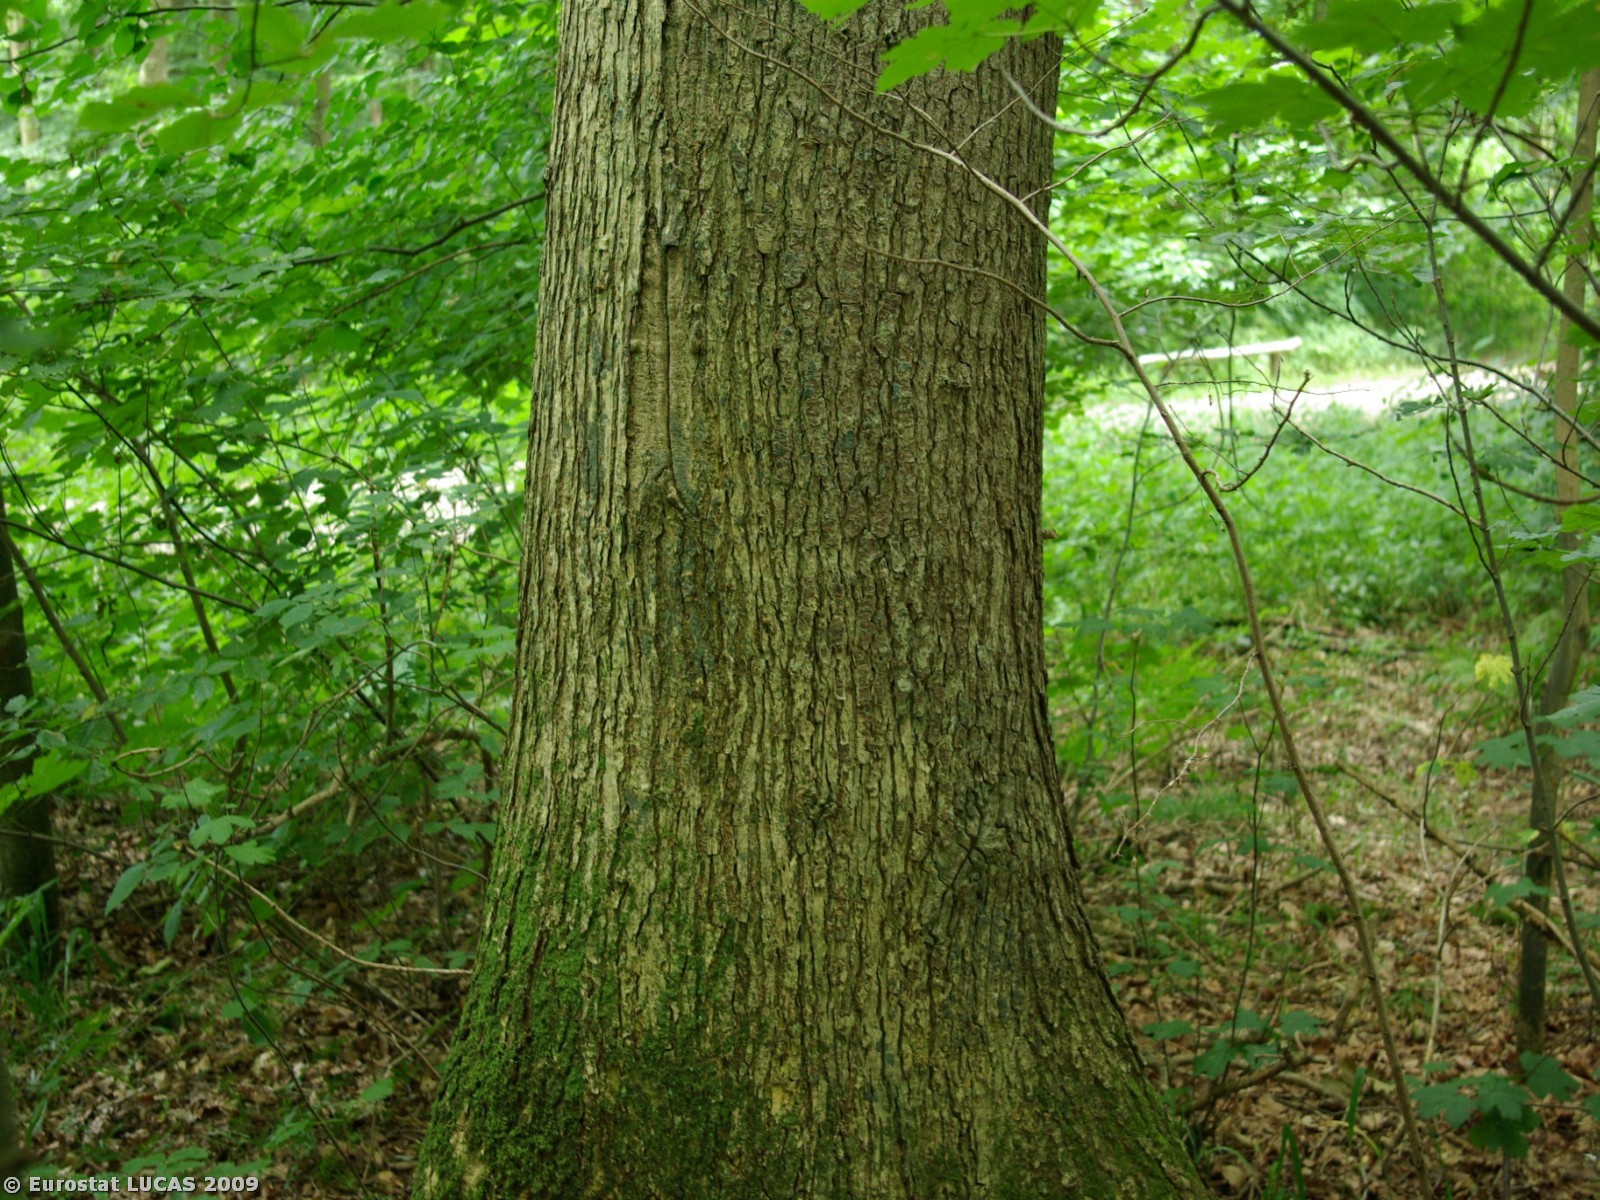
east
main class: Woodland
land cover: Broadleaved woodland
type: mesophytic deciduous forest
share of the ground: > 75 %
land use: Forestry
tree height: > 5 m
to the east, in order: Broadleaved woodland; Tracks; Broadleaved woodland; Tracks; Broadleaved woodland; Ditches and canals; Broadleaved woodland; Rivers and streams; Broadleaved woodland; Fences; Broadleaved woodland; Fences; Broadleaved woodland
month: July
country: DK
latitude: 55.0194
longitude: 9.8906
